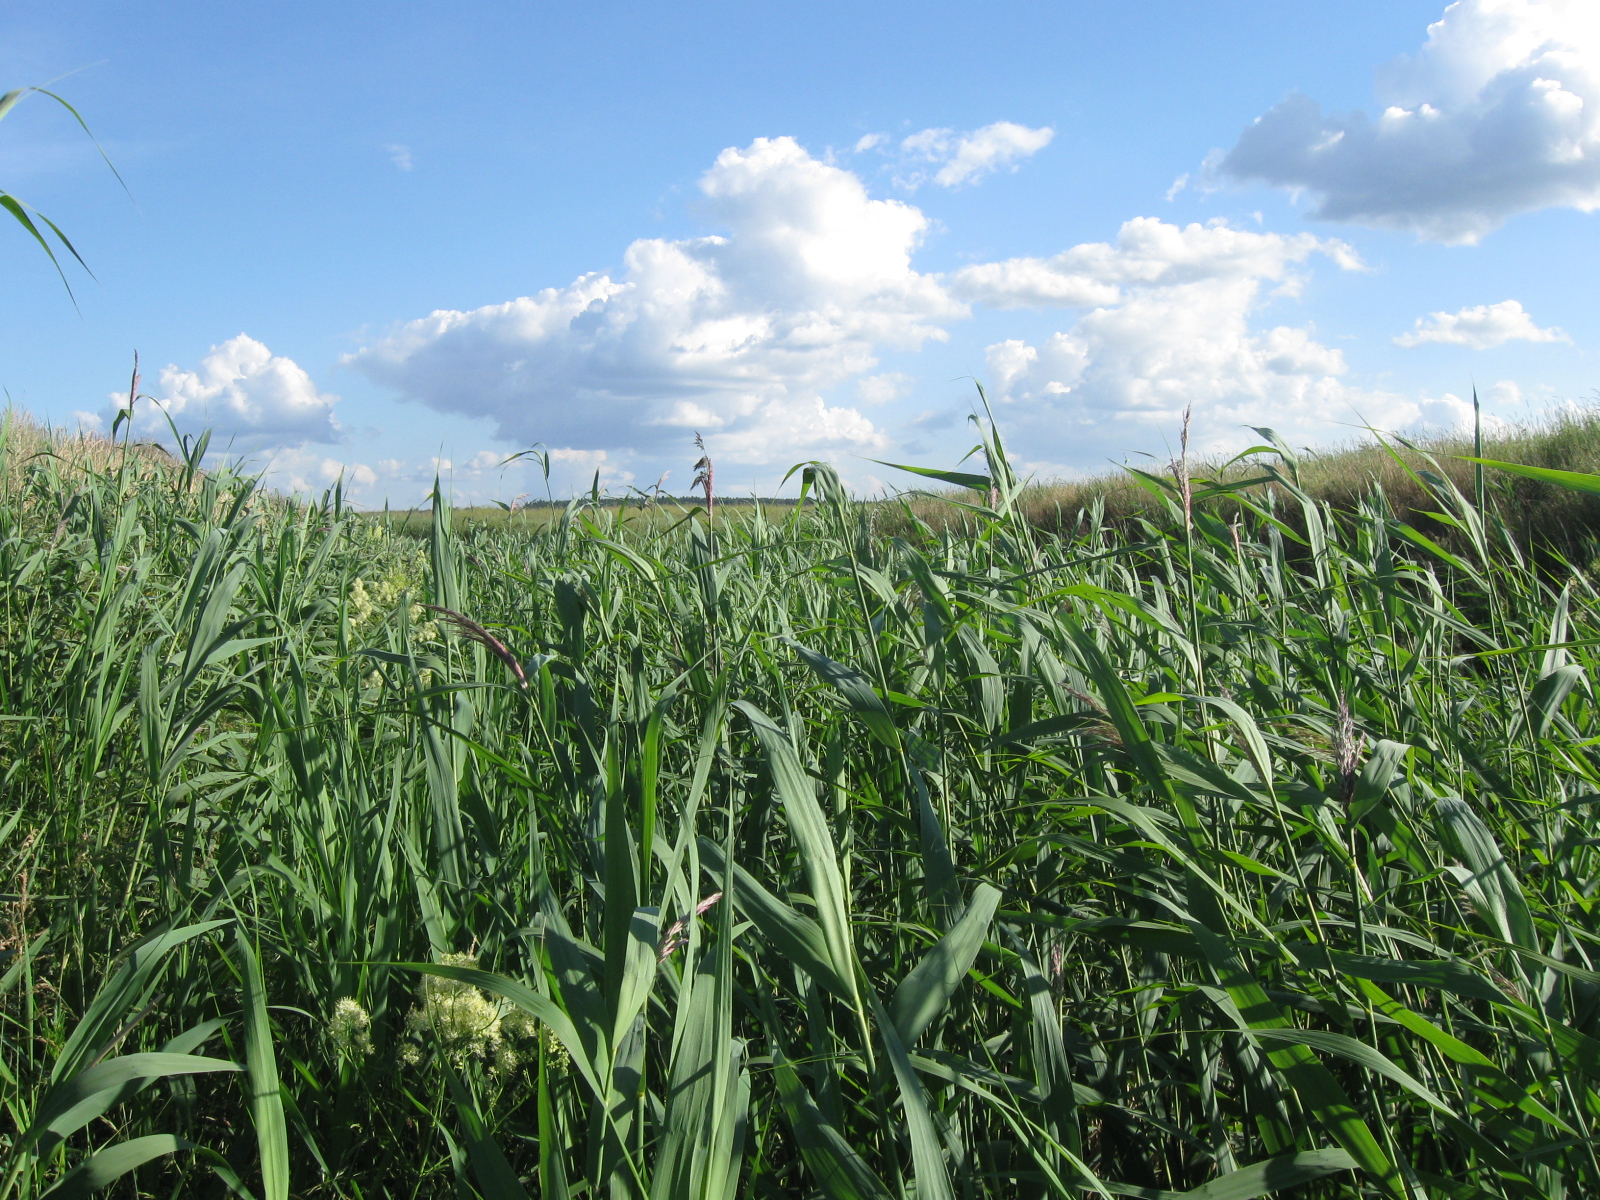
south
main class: Grassland
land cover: Spontaneously vegetated surfaces
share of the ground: > 75 %
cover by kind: herbaceous plants 100 %
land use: Semi-natural and natural areas not in use
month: July
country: LT
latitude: 54.2618
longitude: 24.3312
